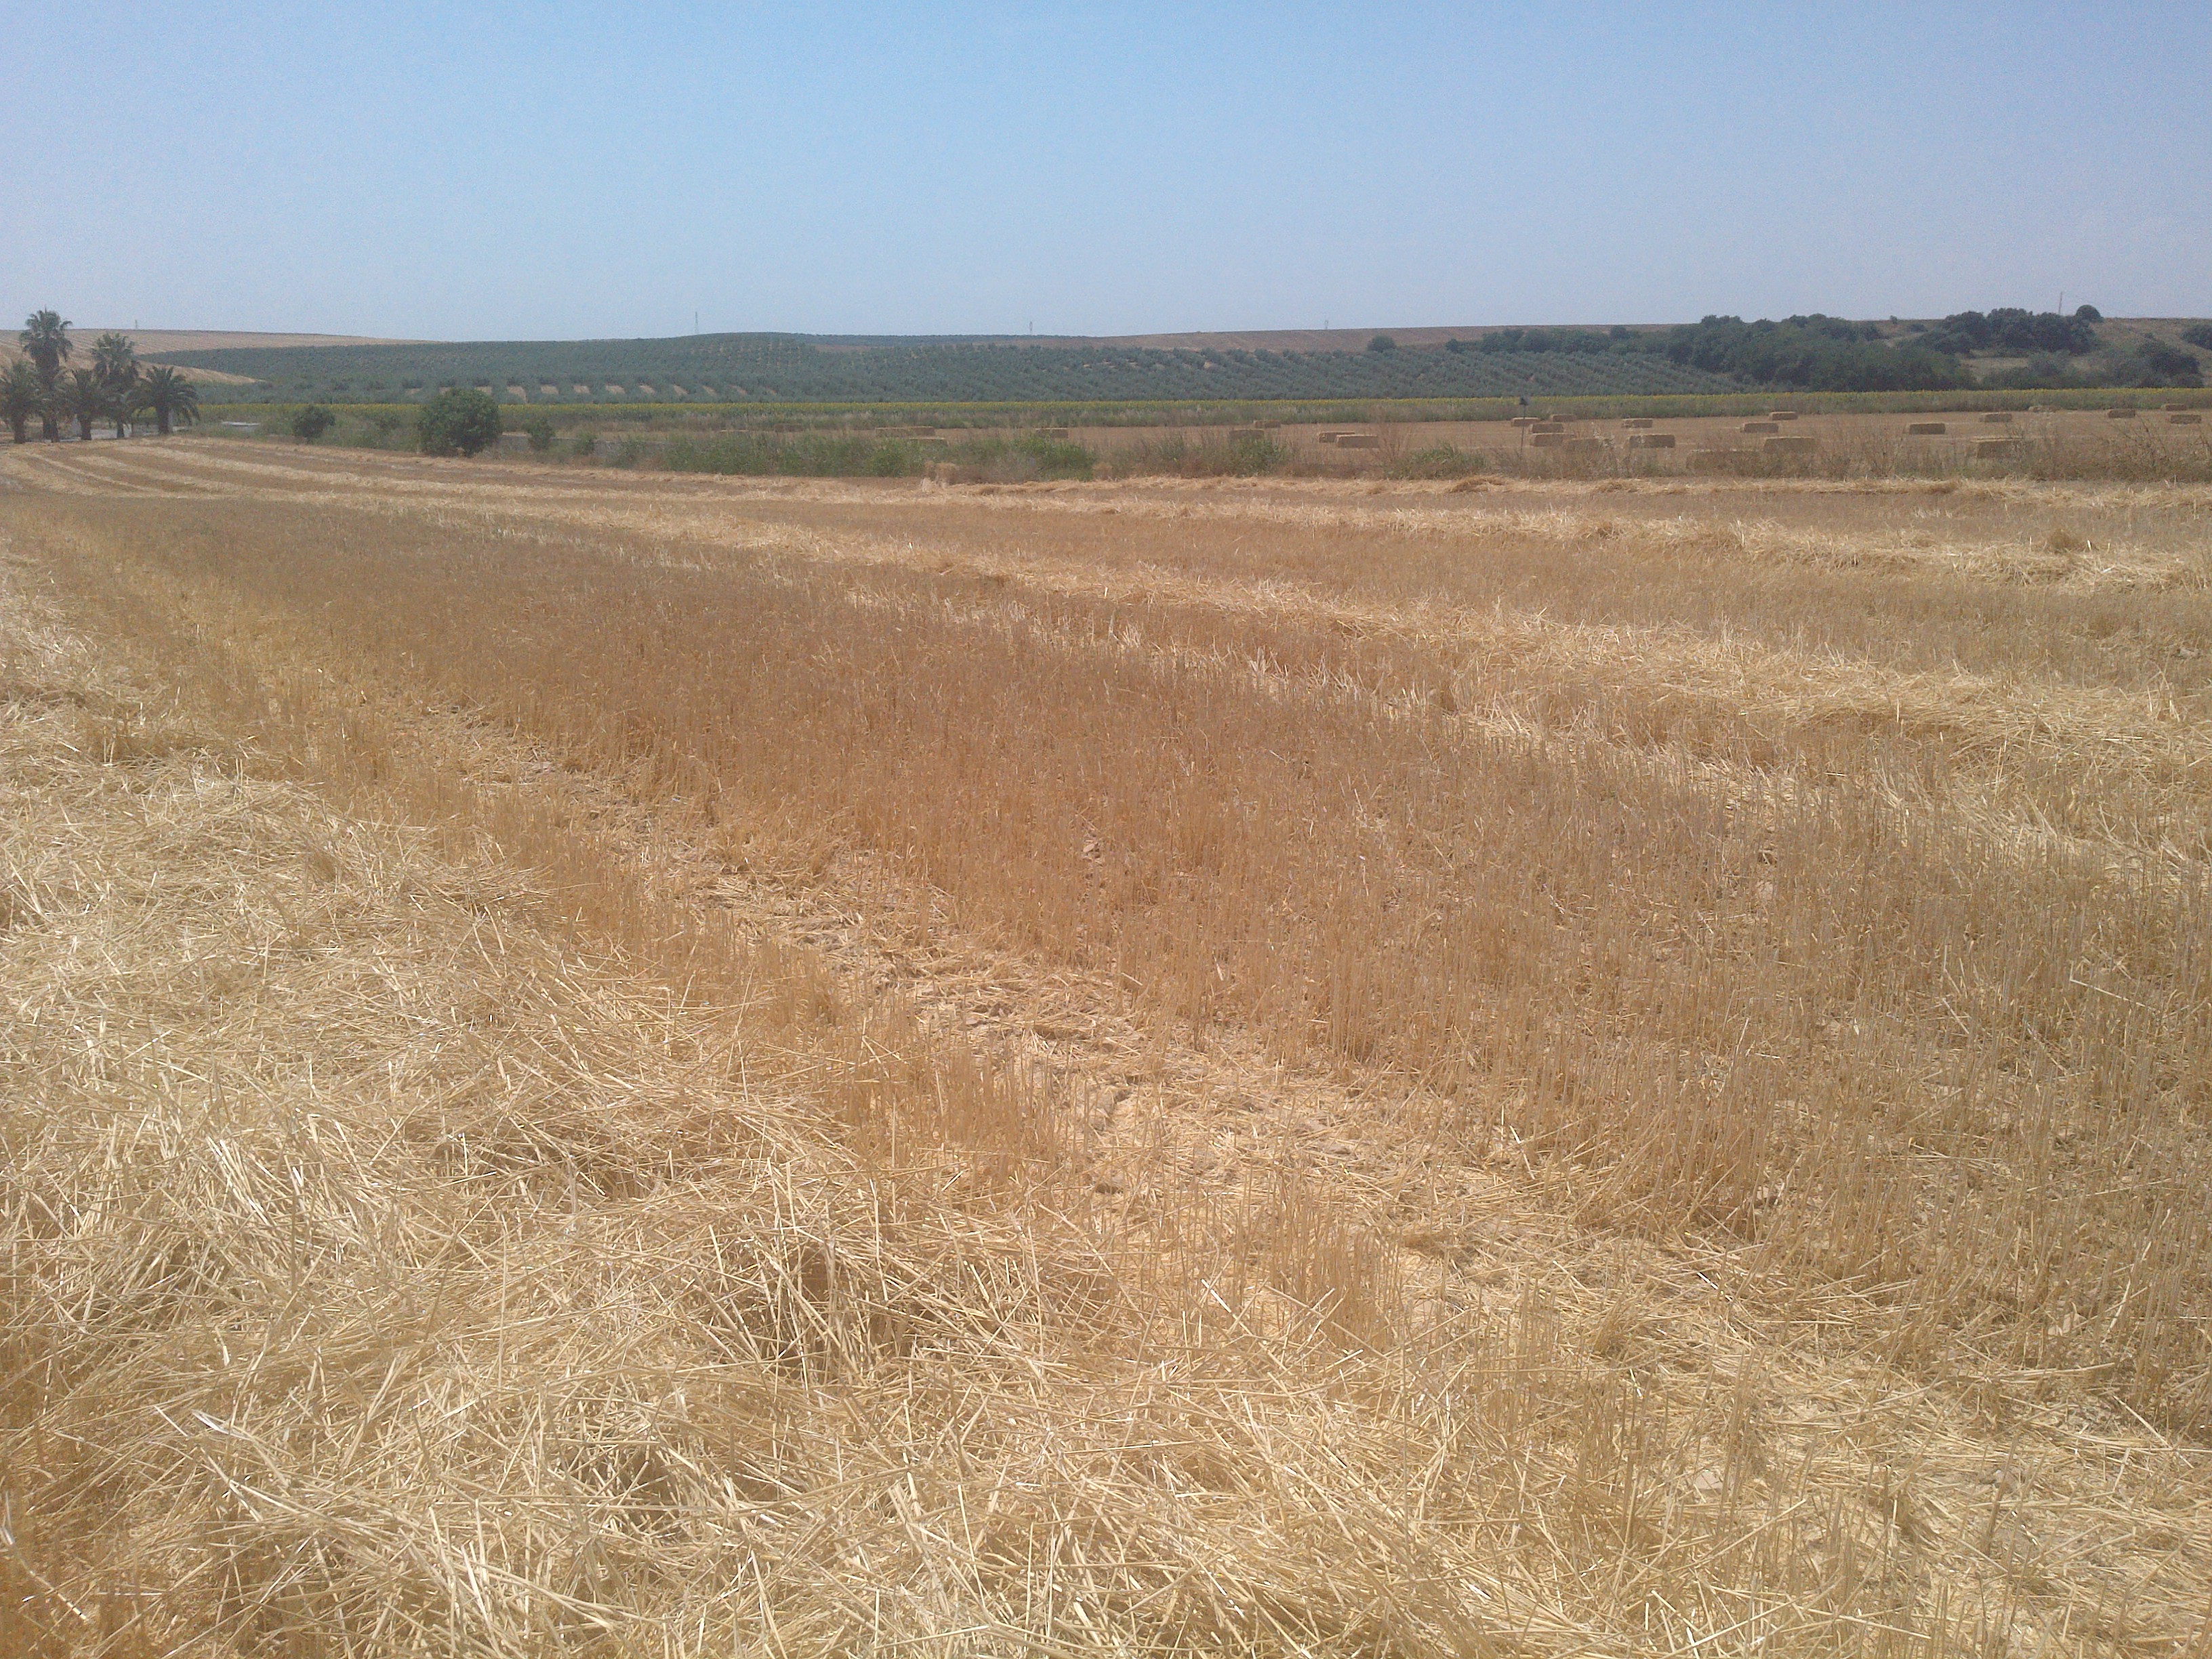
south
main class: Cropland
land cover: Durum wheat
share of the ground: < 10 %
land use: Agriculture (excluding fallow land and kitchen gardens)
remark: Harvested field
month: June
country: ES
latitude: 37.8058
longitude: -4.9743
